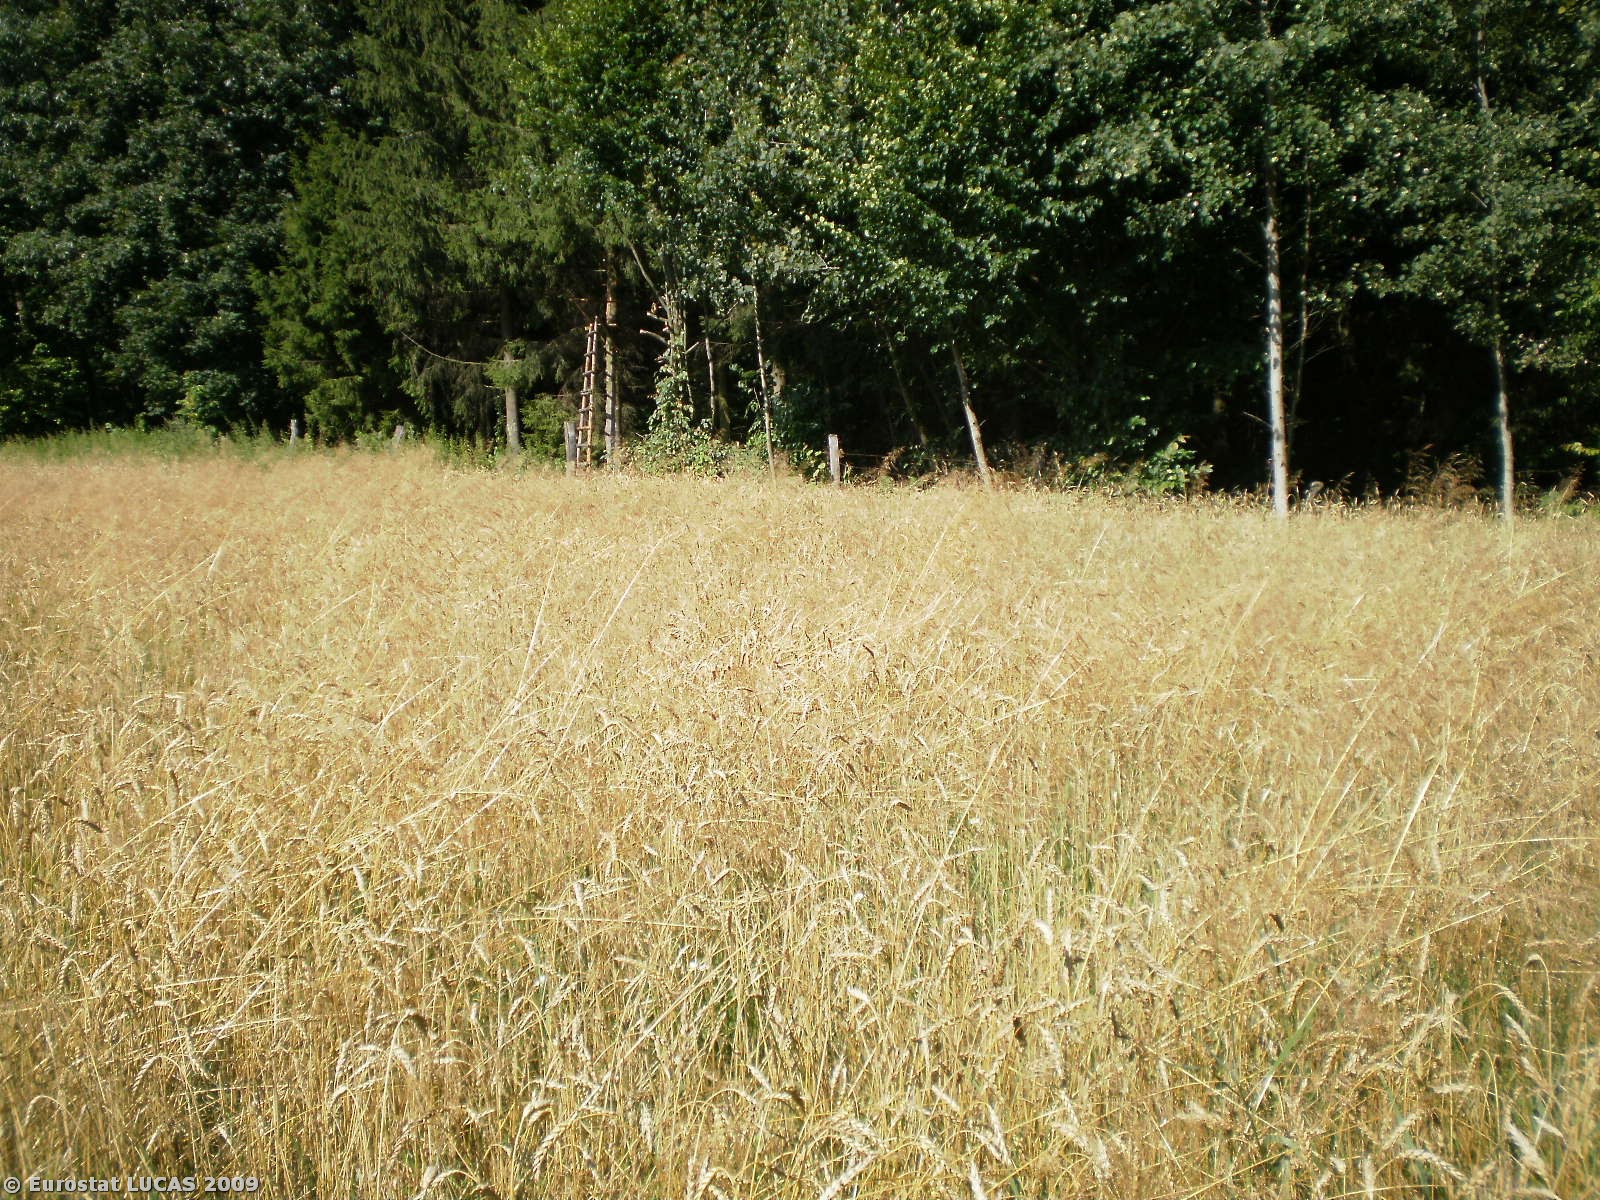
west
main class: Cropland
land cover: Common wheat
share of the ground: > 75 %
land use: Agriculture (excluding fallow land and kitchen gardens)
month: August
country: PL
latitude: 53.8094
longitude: 20.5617
